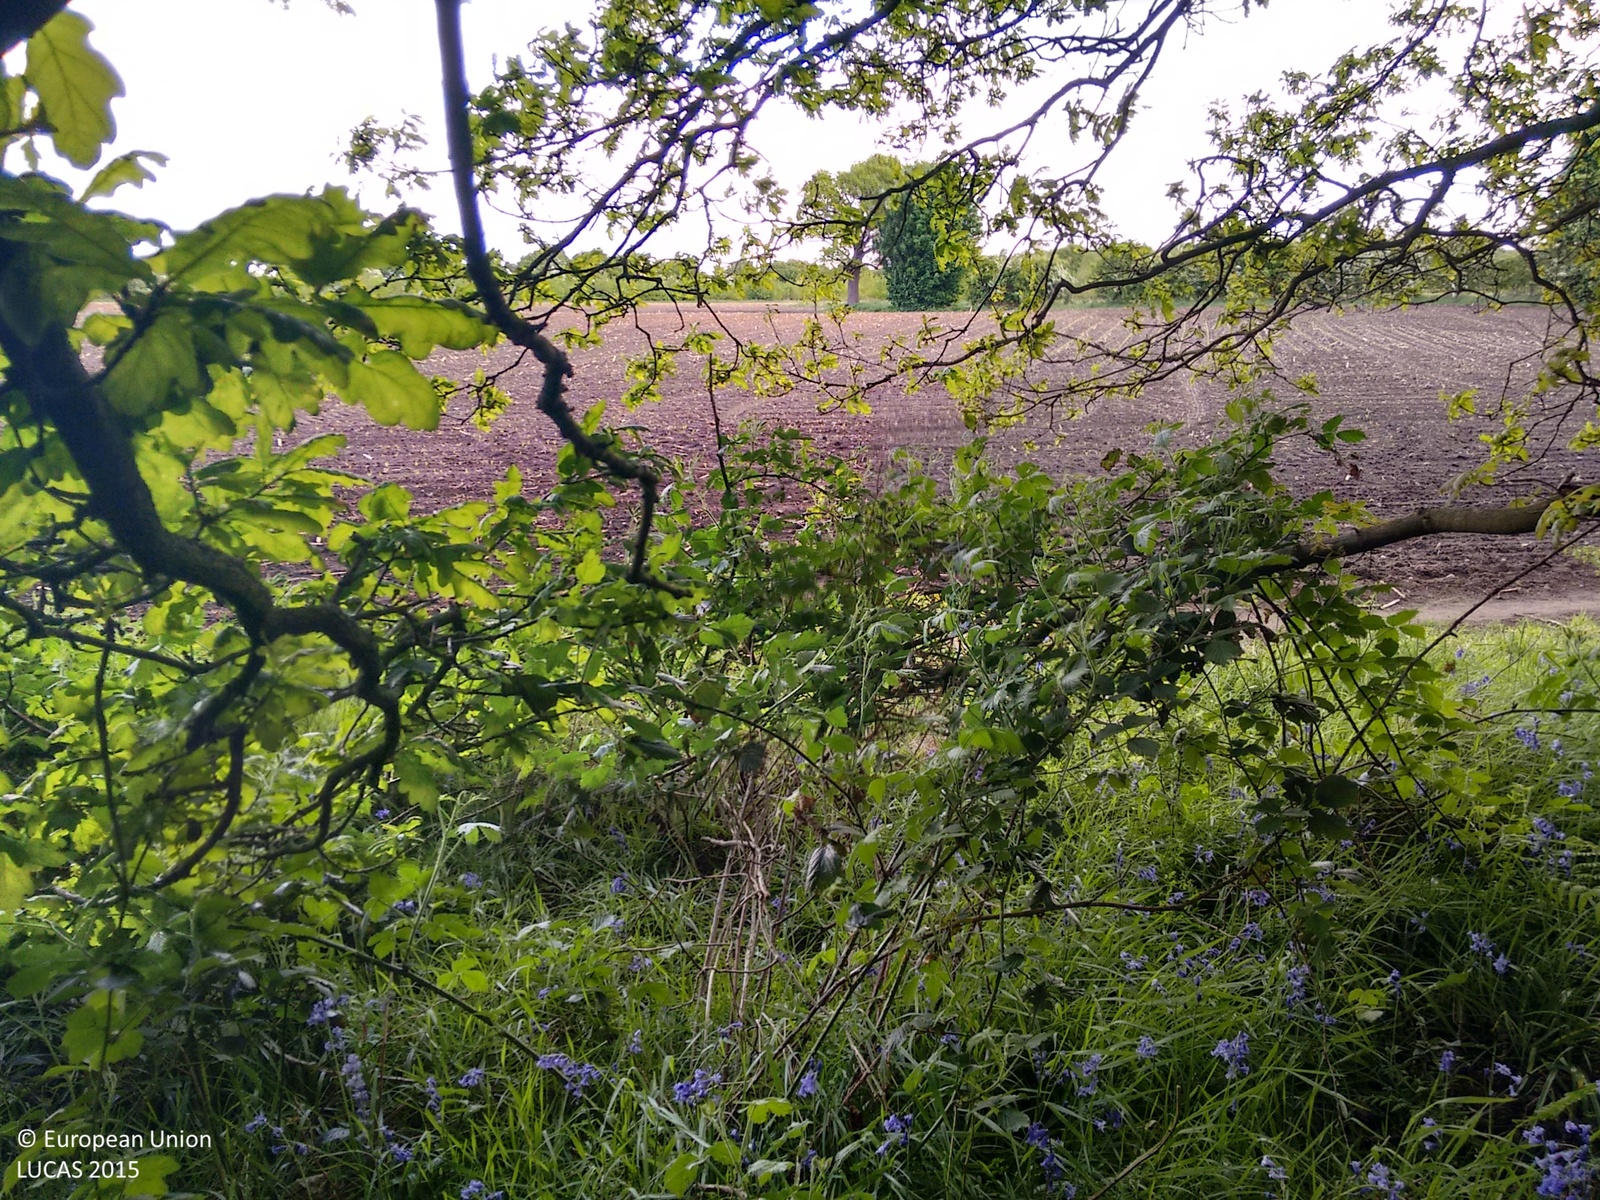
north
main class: Woodland
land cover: Broadleaved woodland
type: mesophytic deciduous forest
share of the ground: > 75 %
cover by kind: broadleaved forest trees 100 %
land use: Semi-natural and natural areas not in use
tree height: > 5 m
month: May
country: GB
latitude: 53.5129
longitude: -1.0372
